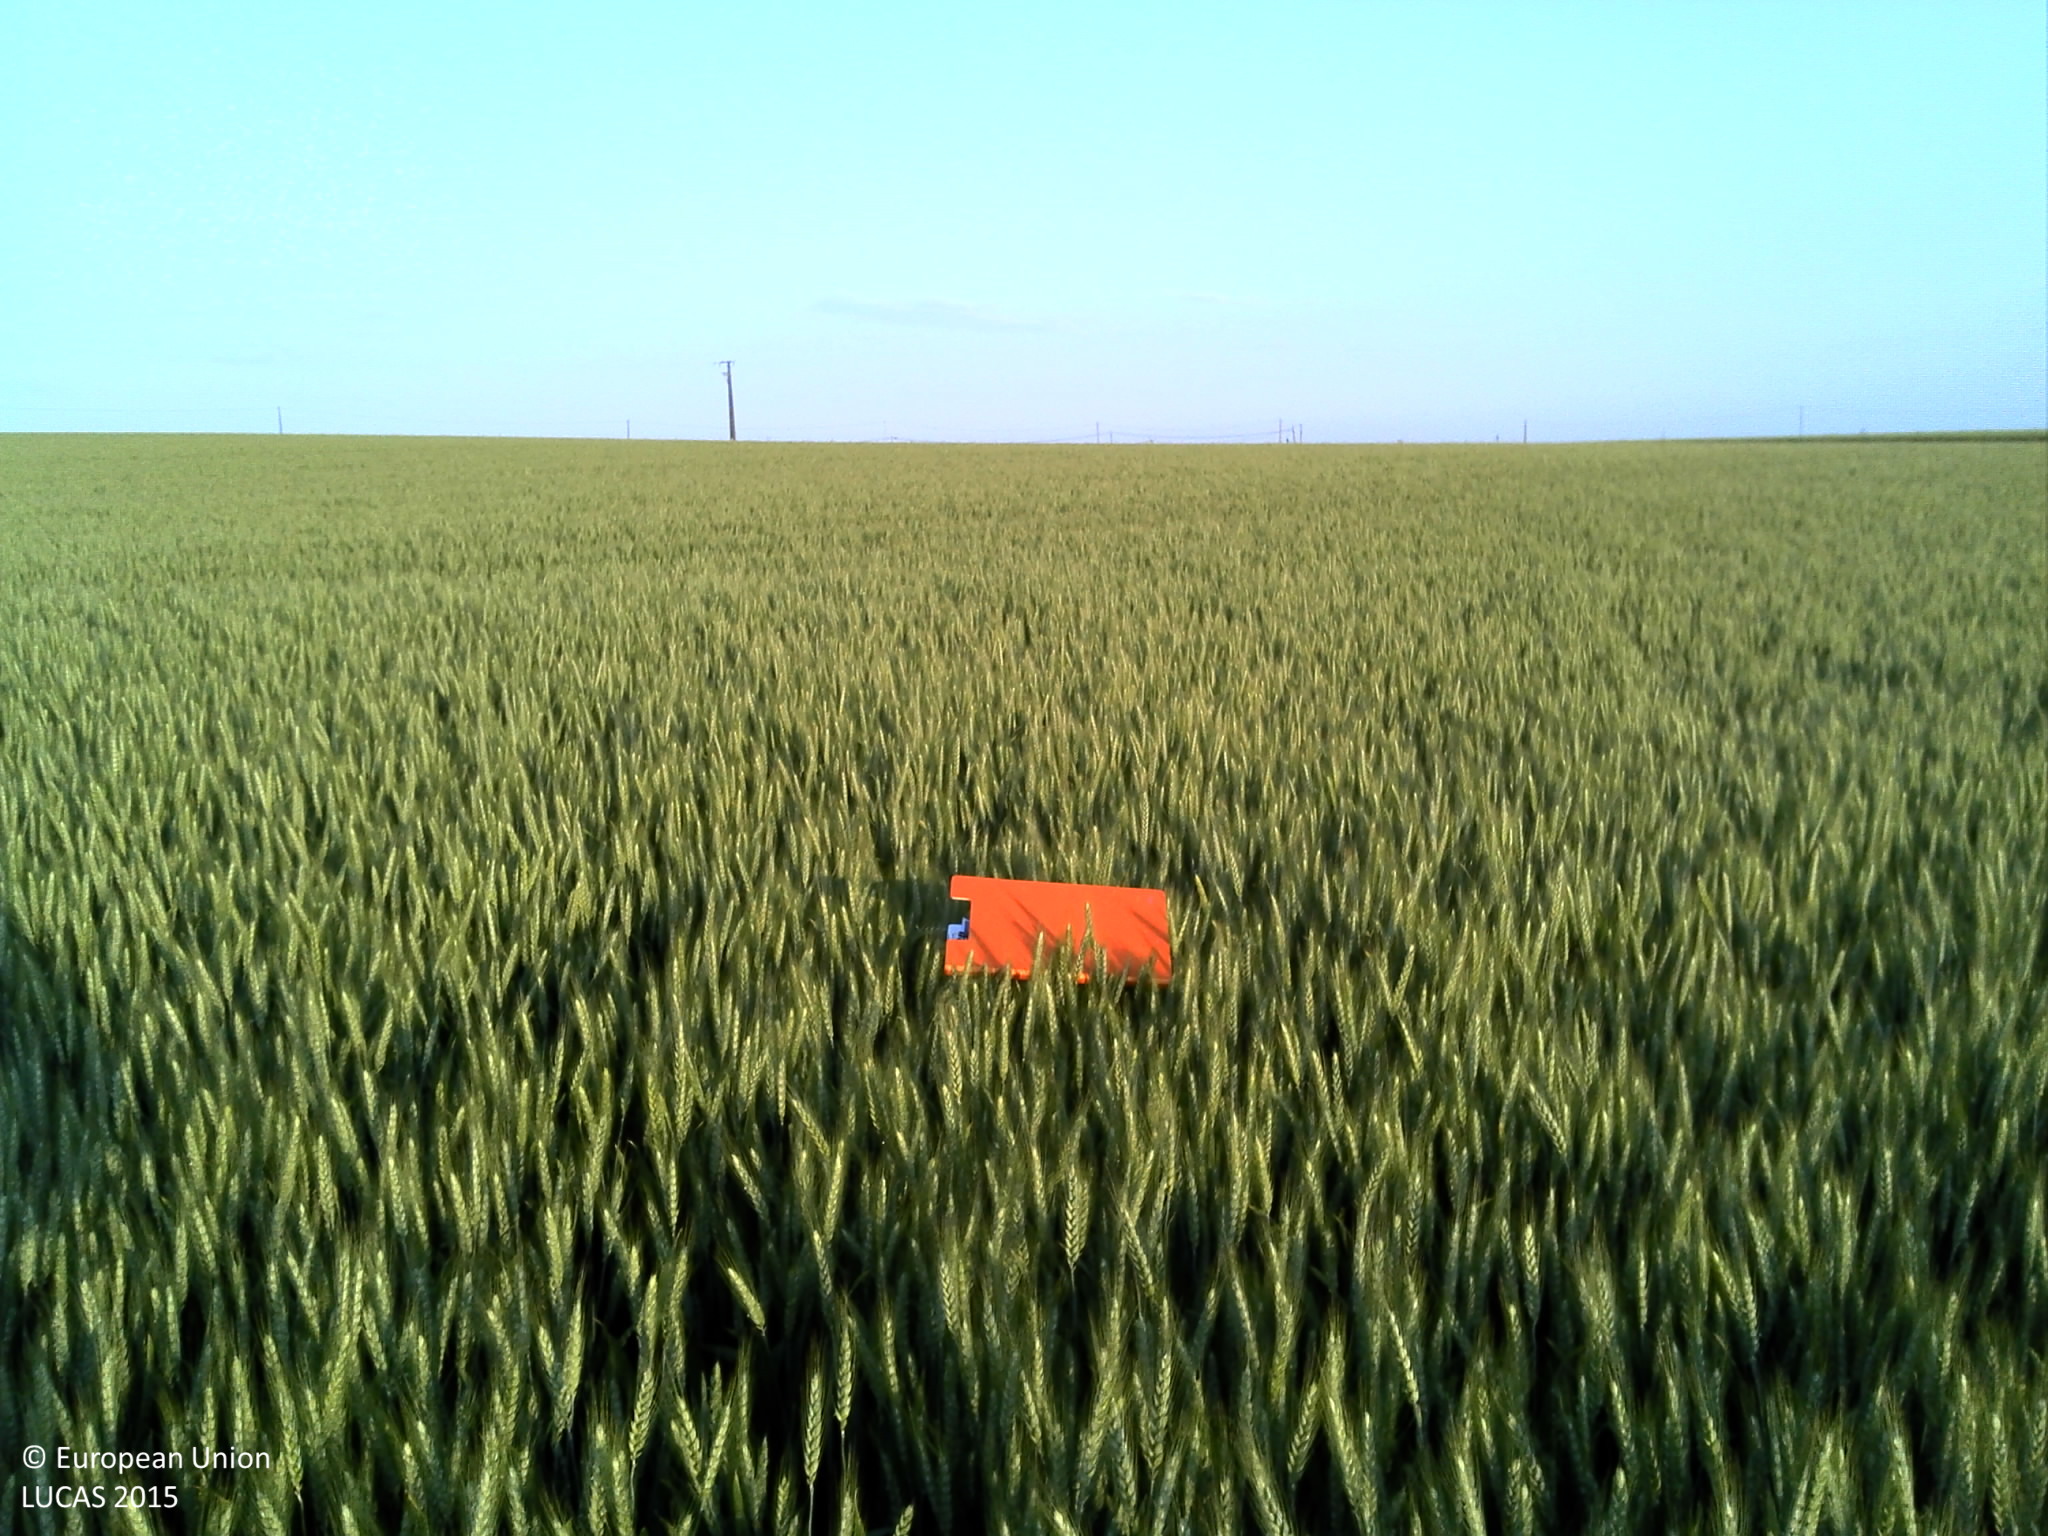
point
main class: Cropland
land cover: Durum wheat
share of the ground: > 75 %
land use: Agriculture (excluding fallow land and kitchen gardens)
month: June
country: FR
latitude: 49.6815
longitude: 0.9825
